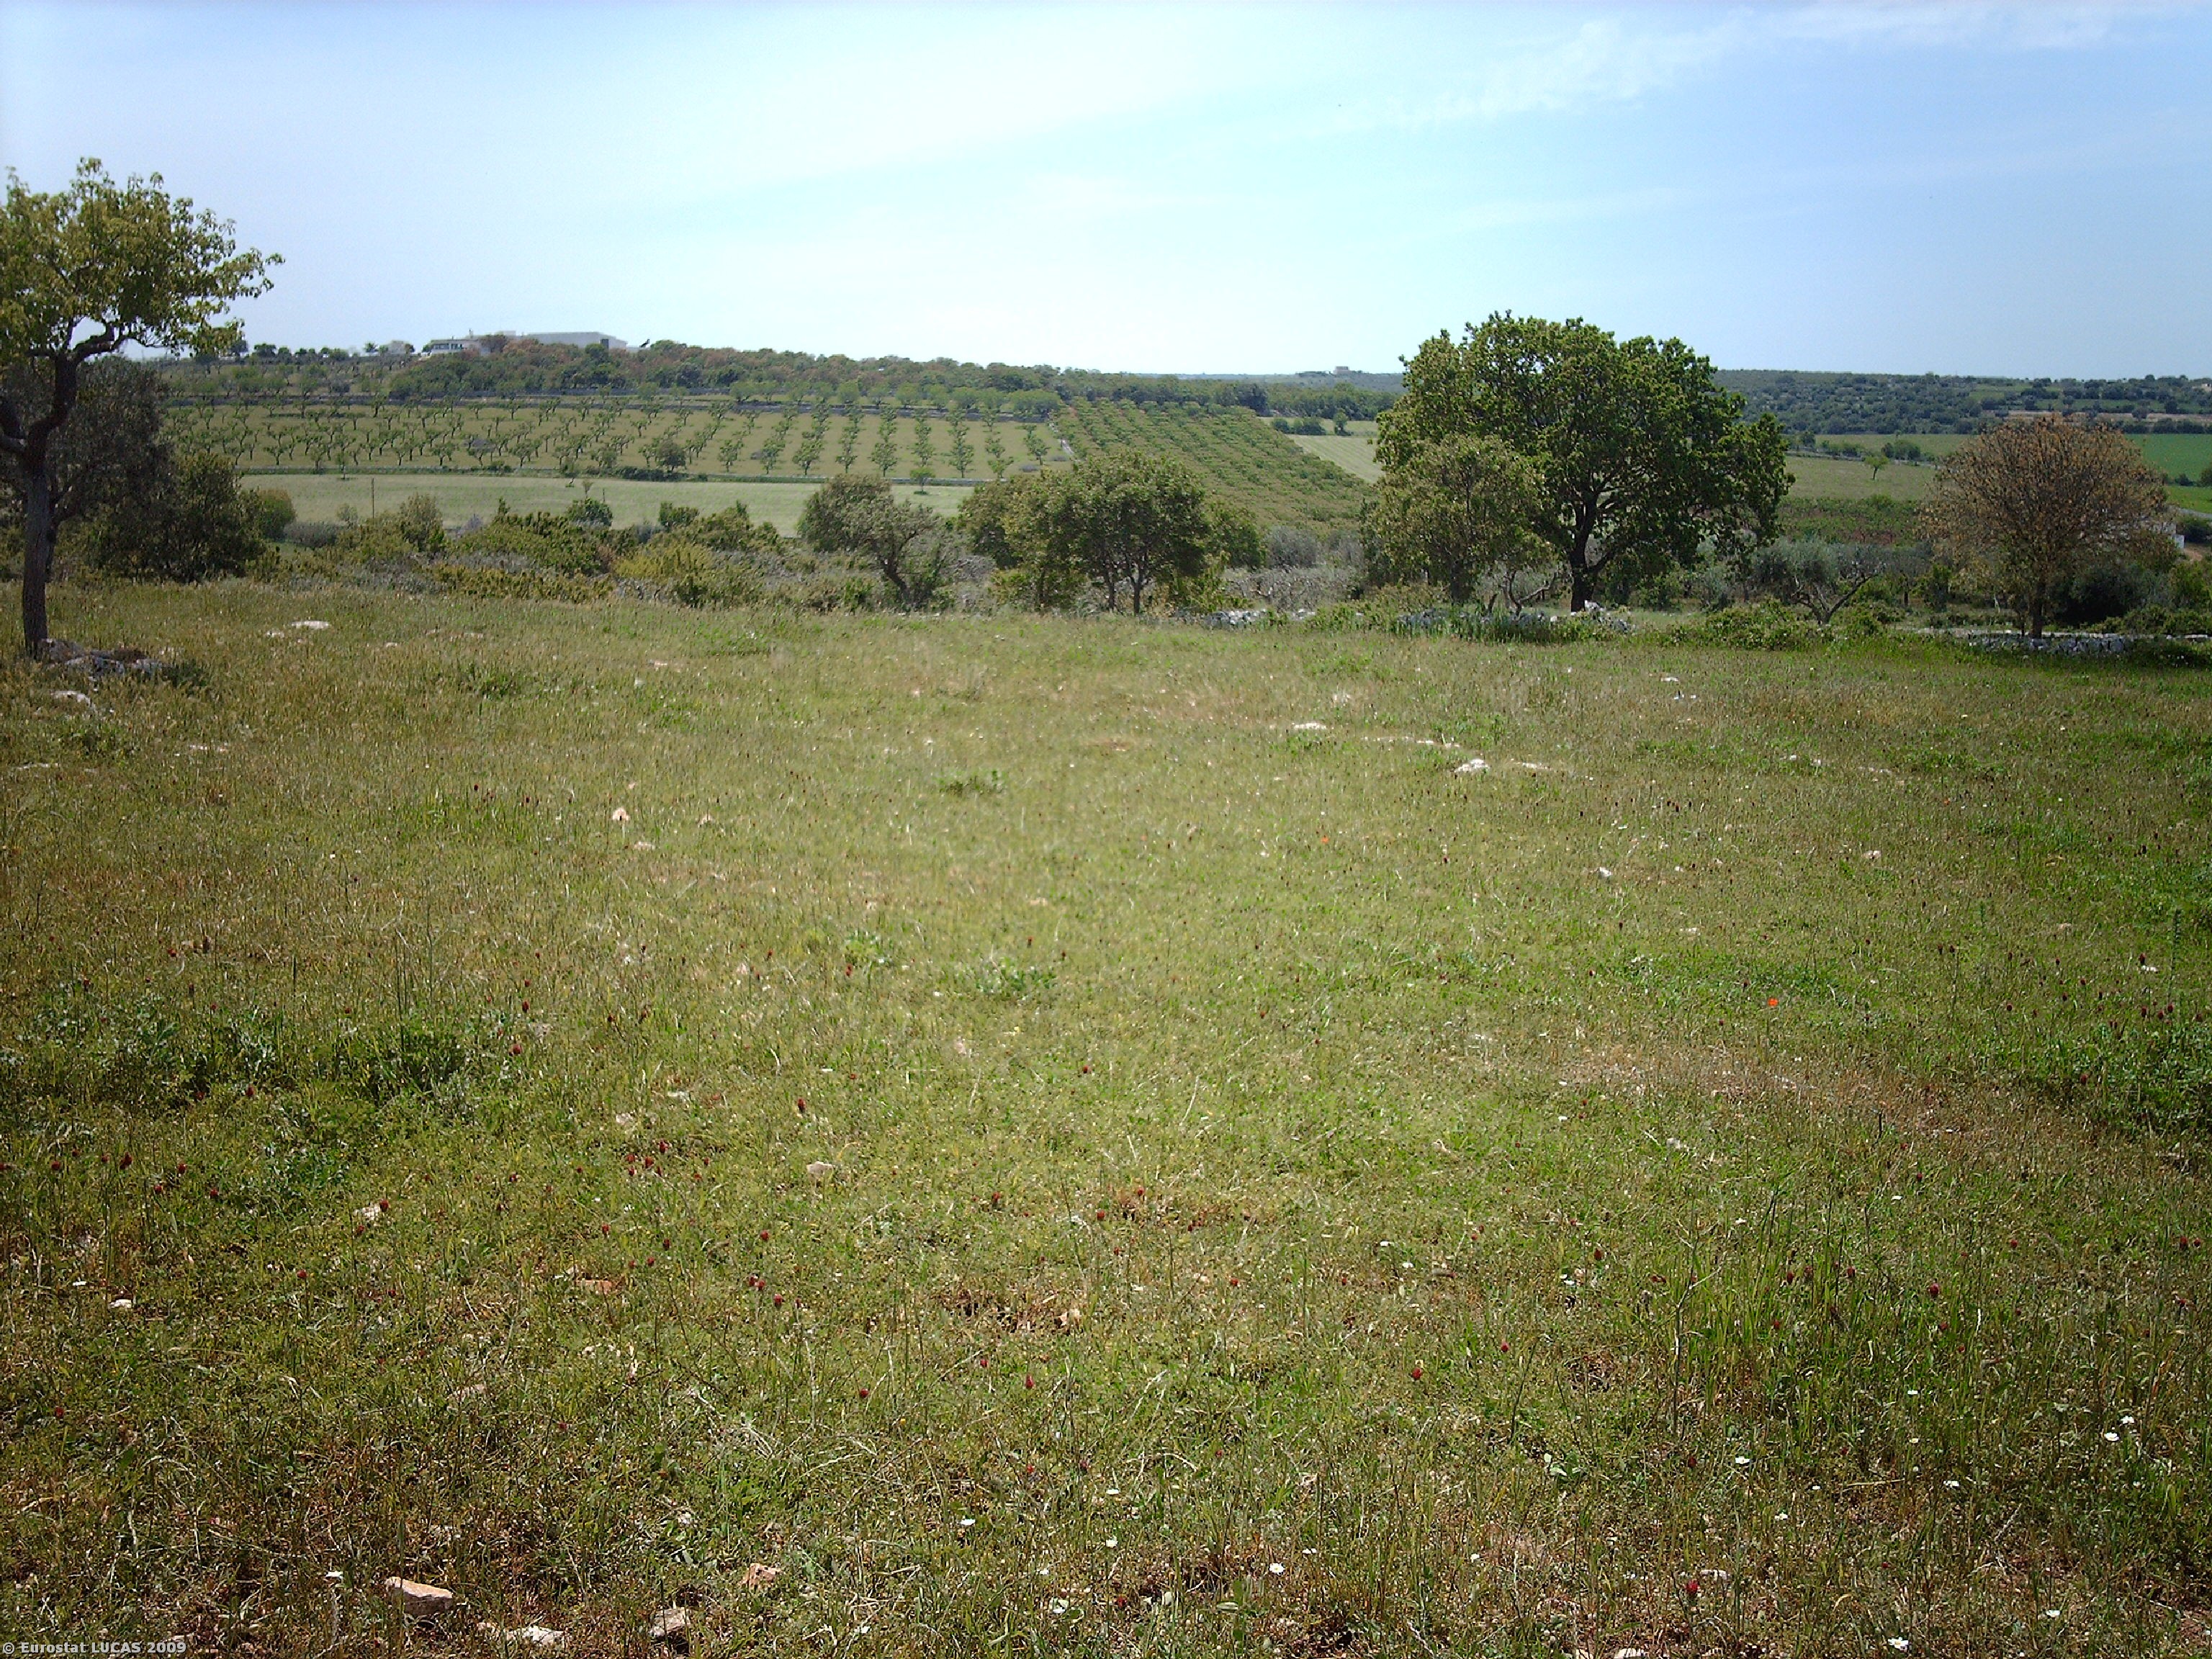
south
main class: Grassland
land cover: Grassland without tree/shrub cover
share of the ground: > 75 %
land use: Agriculture (excluding fallow land and kitchen gardens)
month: May
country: IT
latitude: 40.8316
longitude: 17.0335
